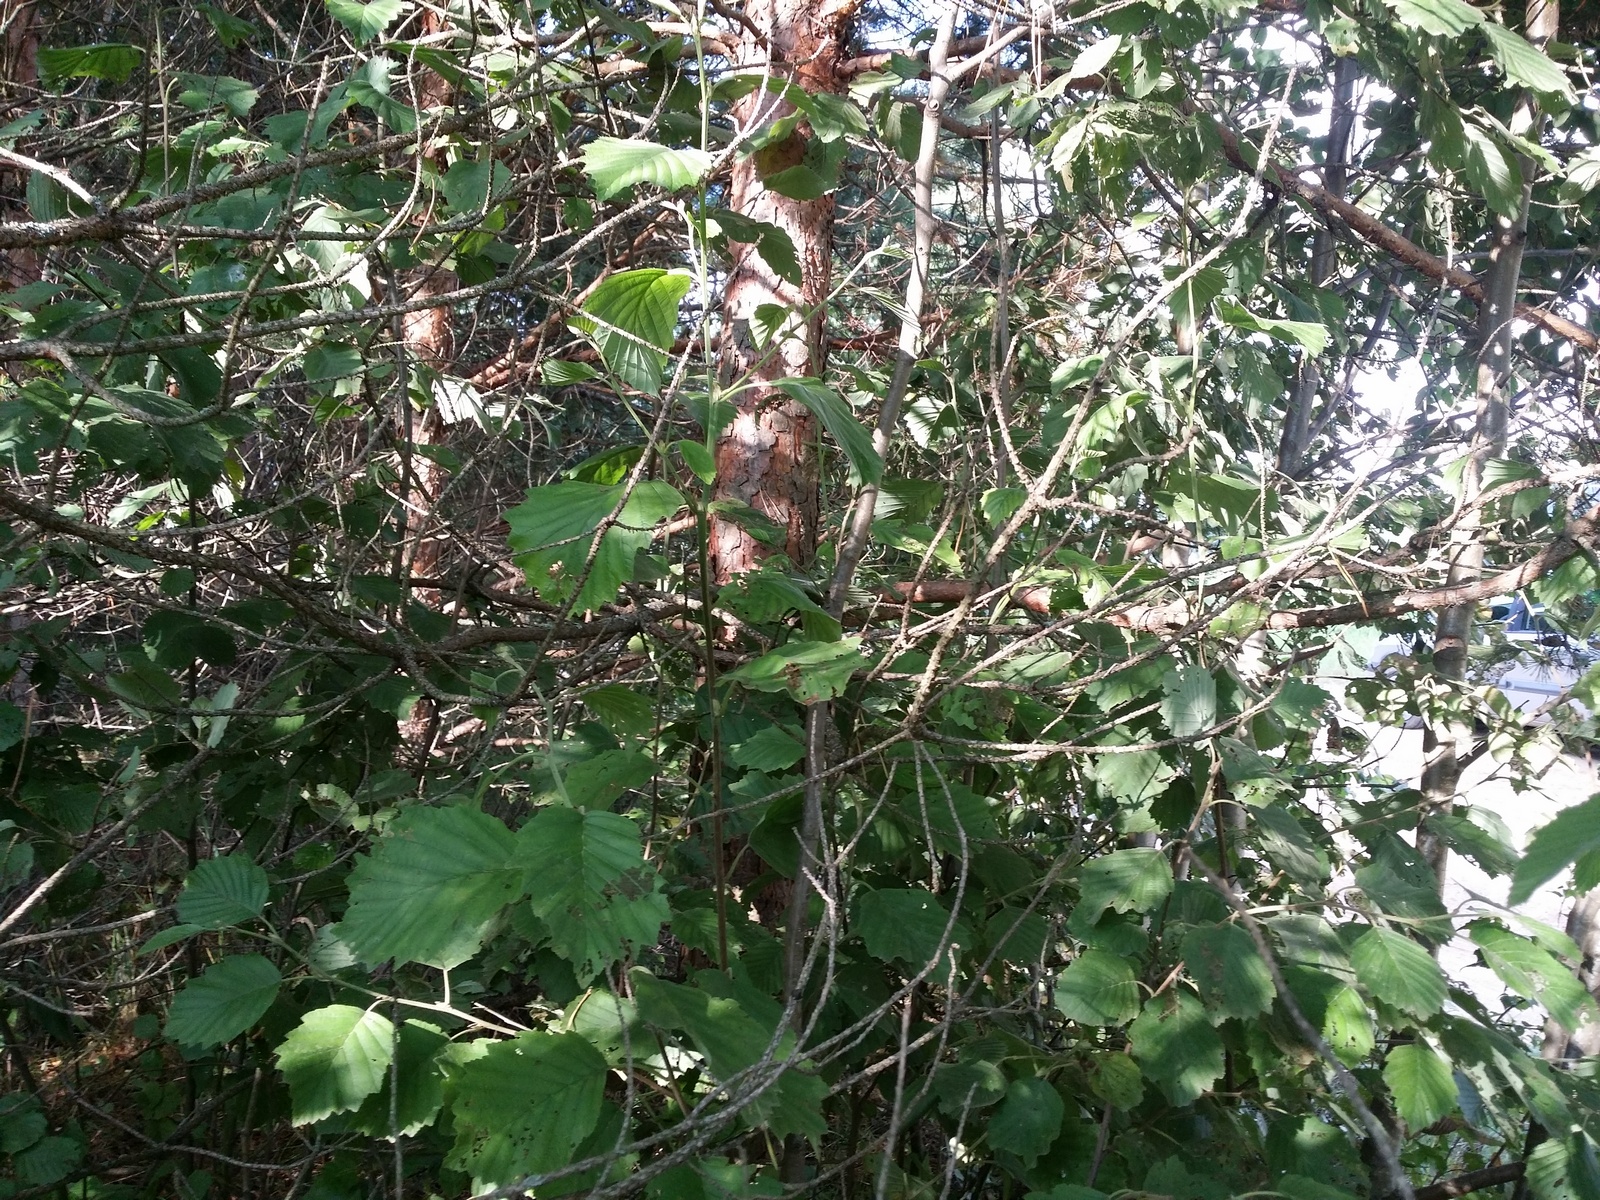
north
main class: Woodland
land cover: Pine dominated mixed woodland
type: hemiboreal forest and nemoral coniferous forest and mixed broadleaved-coniferous forest
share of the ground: 50 - 75 %
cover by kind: coniferous forest trees 45 %, broadleaved forest trees 25 %, lichens and mosses 25 %, herbaceous plants 5 %
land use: Forestry
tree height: < 5 m
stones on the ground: < 10 %
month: August
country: LV
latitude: 57.5365
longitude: 26.8053
